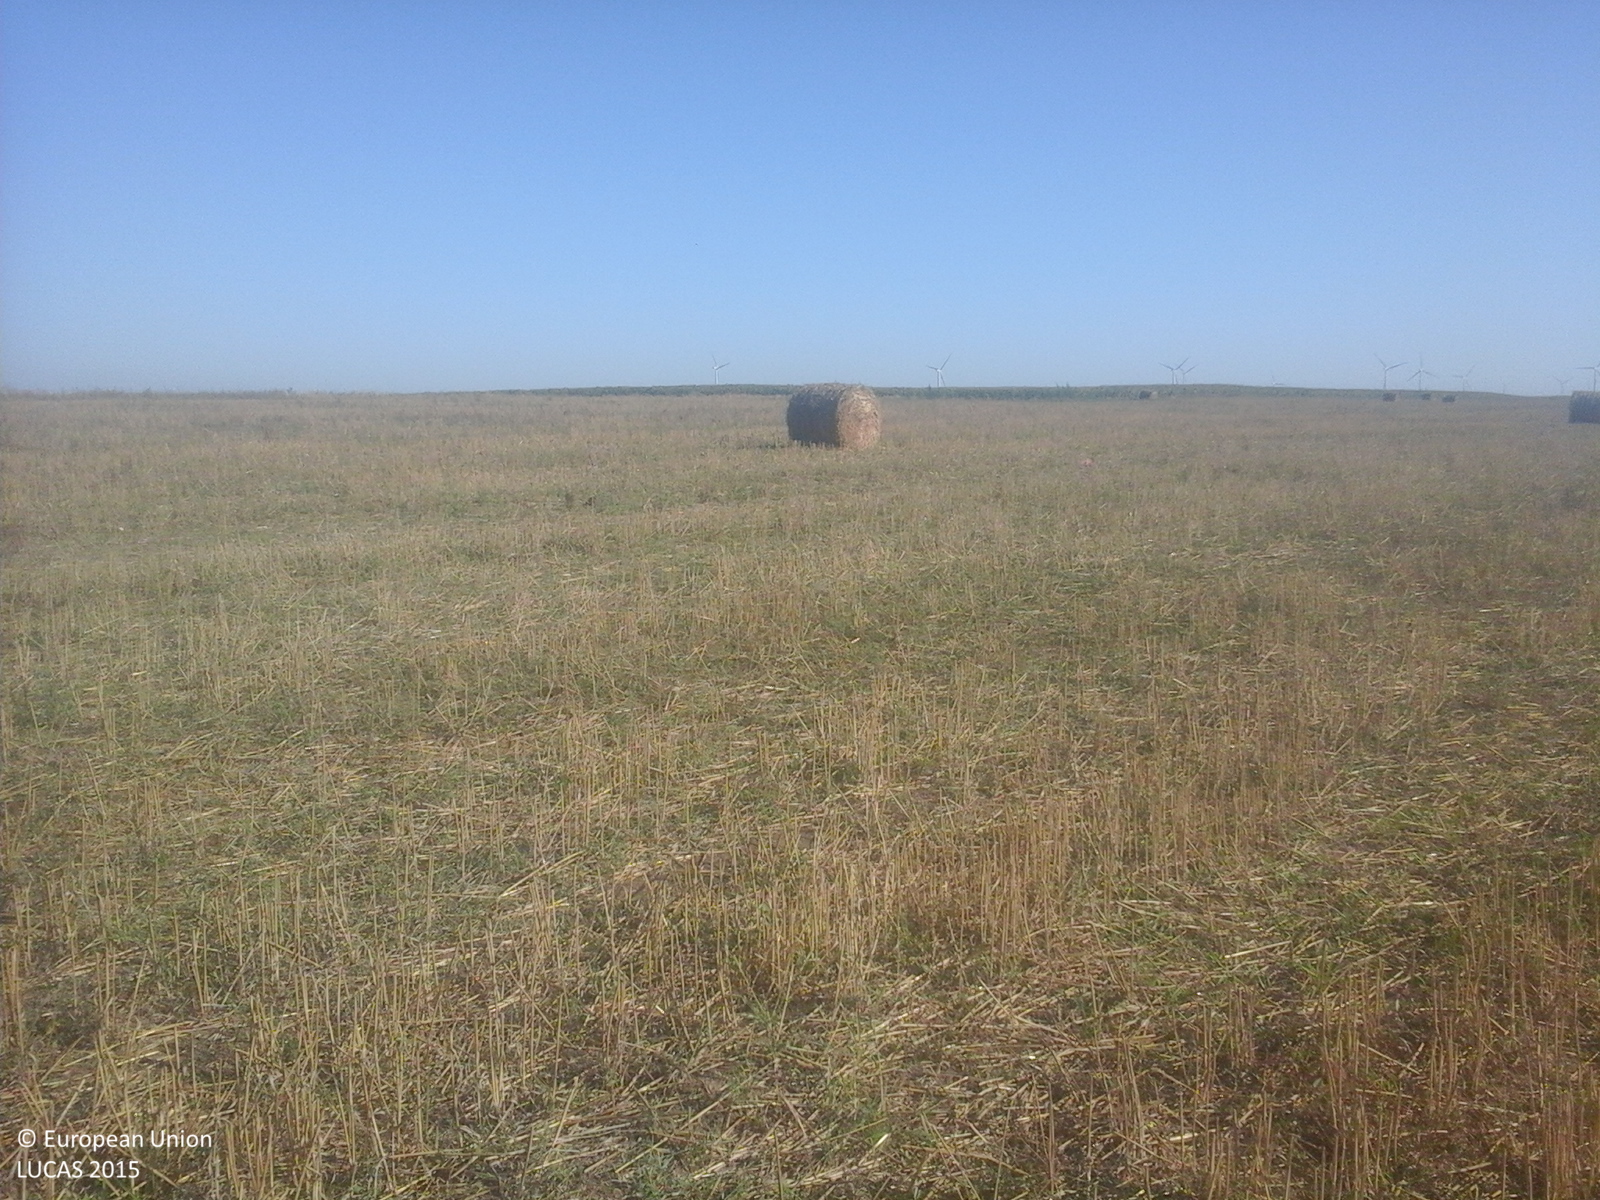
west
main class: Cropland
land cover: Common wheat
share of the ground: > 75 %
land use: Agriculture (excluding fallow land and kitchen gardens)
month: August
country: RO
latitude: 44.5067
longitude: 28.4486
